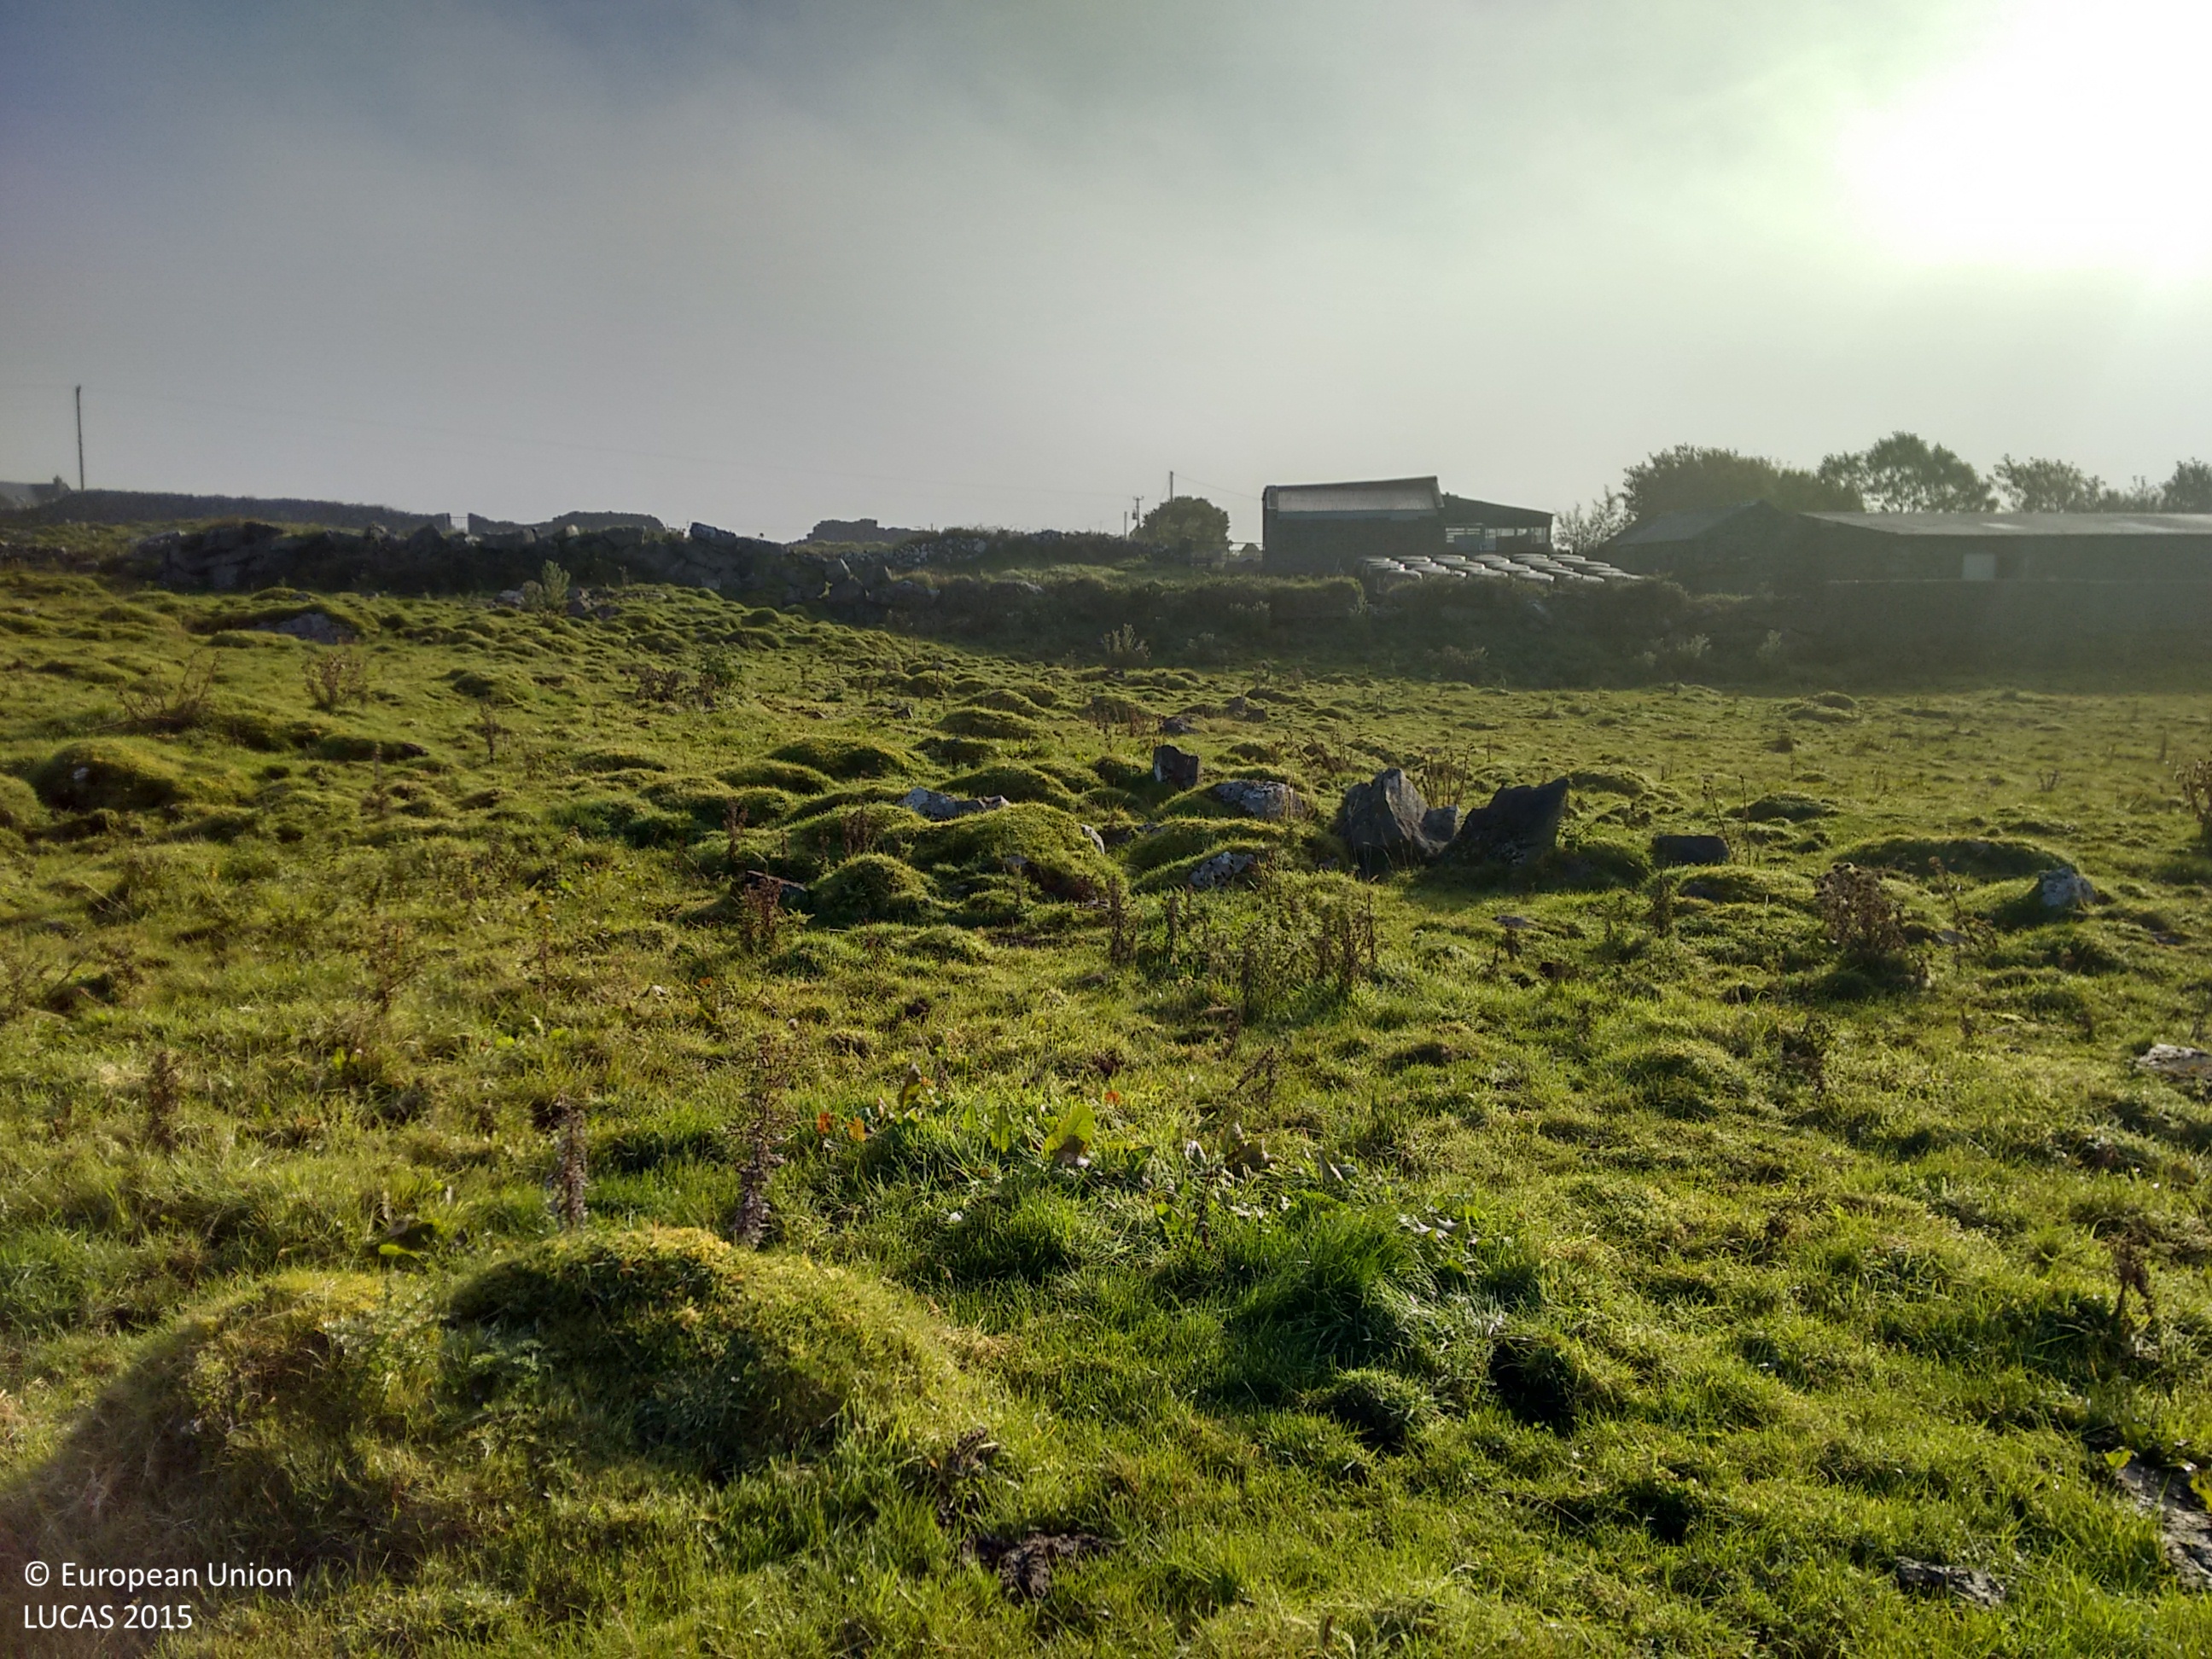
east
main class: Grassland
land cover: Grassland without tree/shrub cover
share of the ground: > 75 %
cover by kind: herbaceous plants 95 %, consolidated bare surface 5 %
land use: Agriculture (excluding fallow land and kitchen gardens)
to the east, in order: Grassland without tree/shrub cover; Rock outcrops; Grassland without tree/shrub cover; Dry stone walls; Abandoned hedges; Grassland without tree/shrub cover; Artificial constructions in urban areas; Dry stone walls; Fences; Grassland without tree/shrub cover
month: September
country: IE
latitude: 53.0361
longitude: -9.2674
